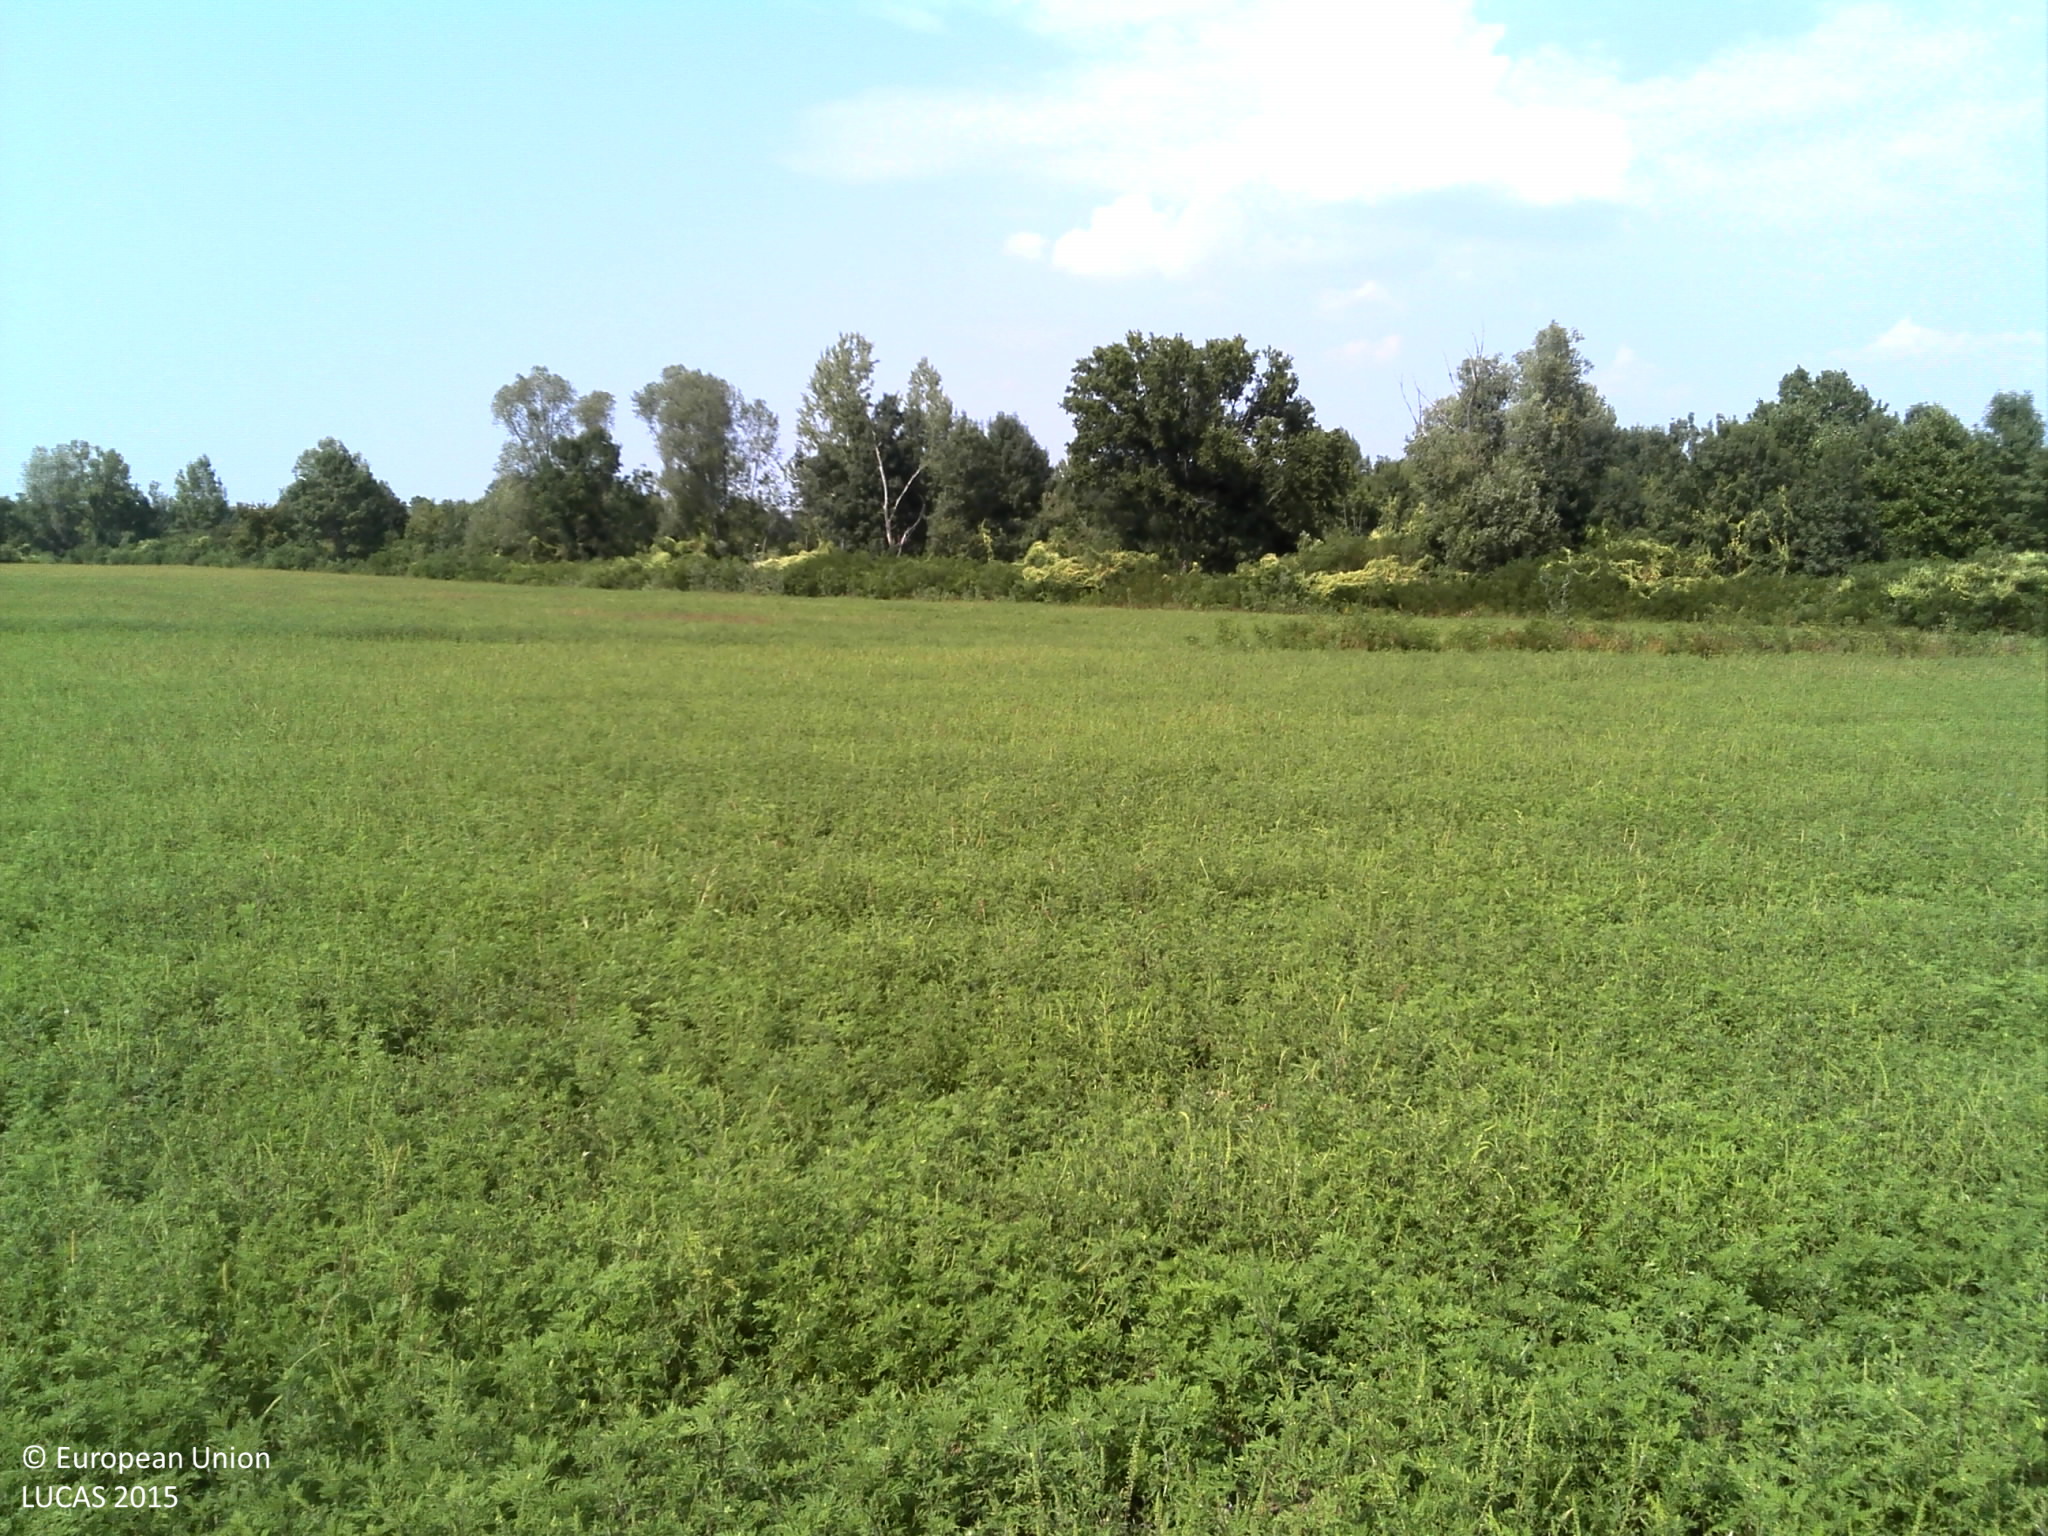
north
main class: Grassland
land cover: Spontaneously vegetated surfaces
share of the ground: > 75 %
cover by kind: herbaceous plants 100 %
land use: Fallow land
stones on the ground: < 10 %
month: August
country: HR
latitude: 45.2064
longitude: 17.1671
